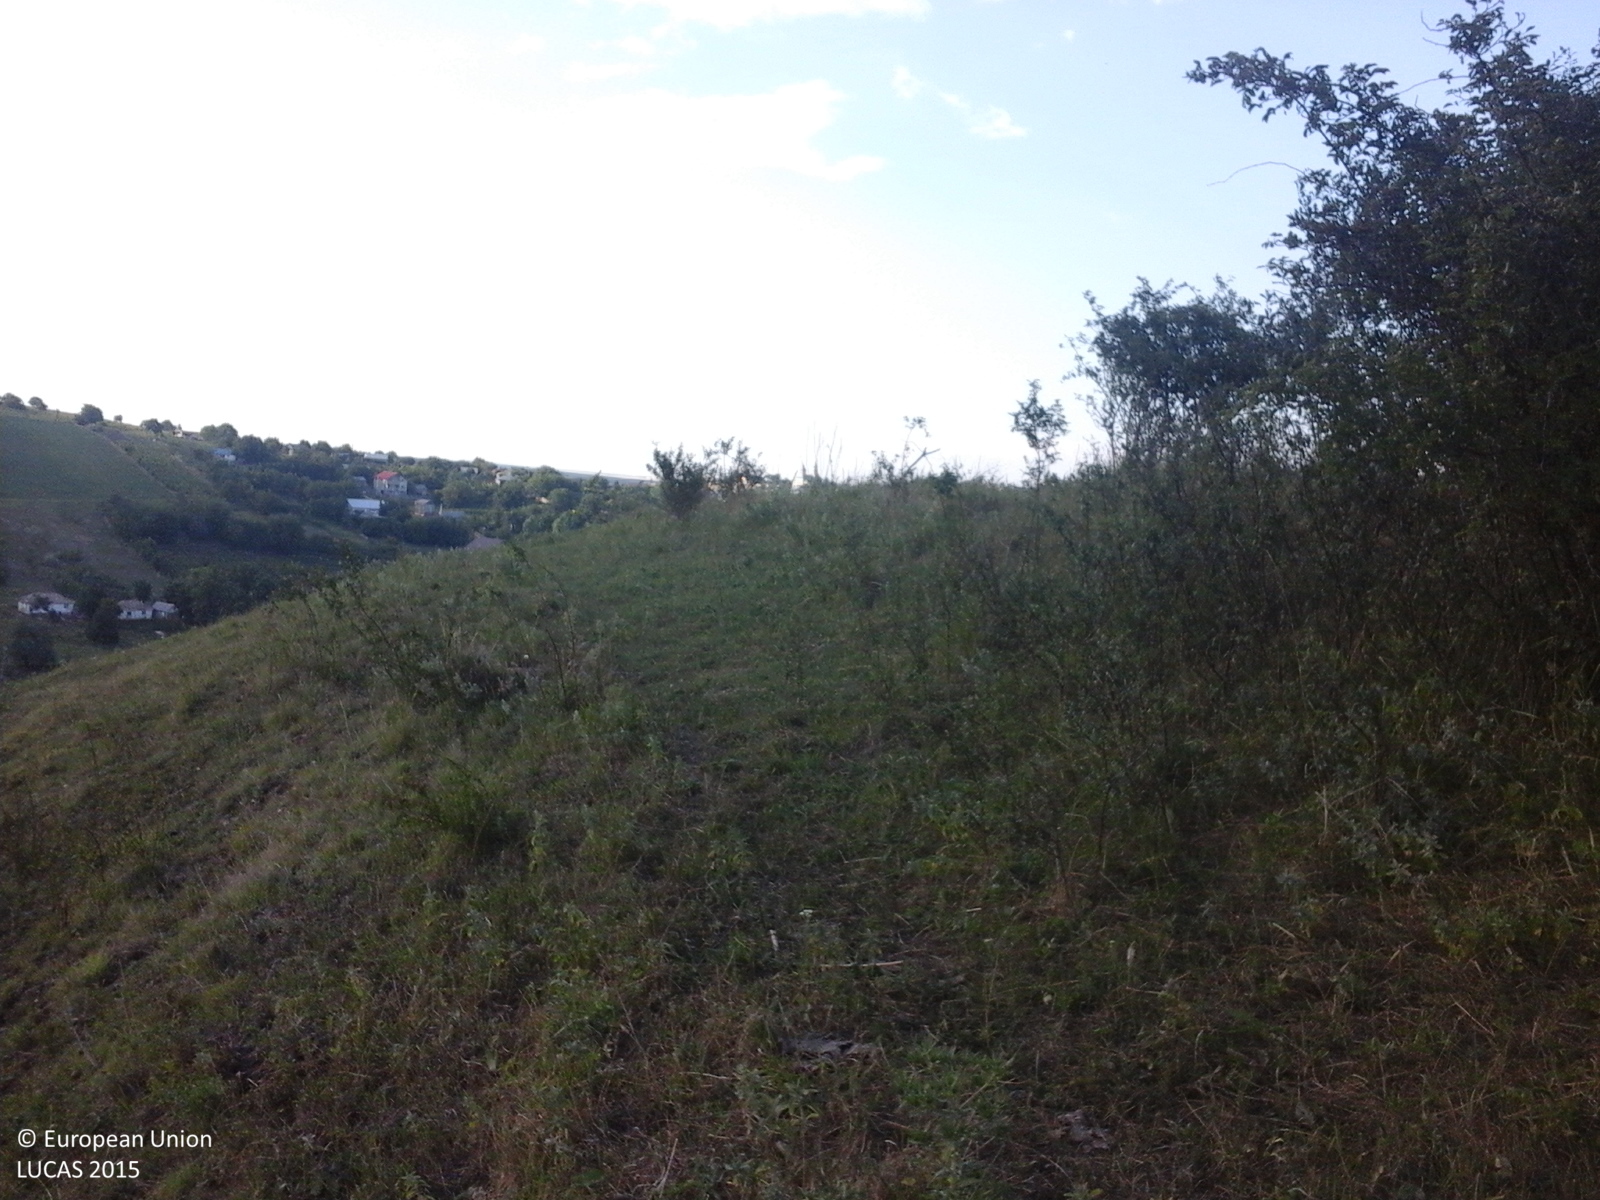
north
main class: Grassland
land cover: Grassland with sparse tree/shrub cover
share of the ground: > 75 %
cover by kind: herbaceous plants 85 %, shrubs 10 %, broadleaved forest trees 5 %
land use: Agriculture (excluding fallow land and kitchen gardens)
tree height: < 5 m
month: June
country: RO
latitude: 47.1834
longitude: 27.0055
